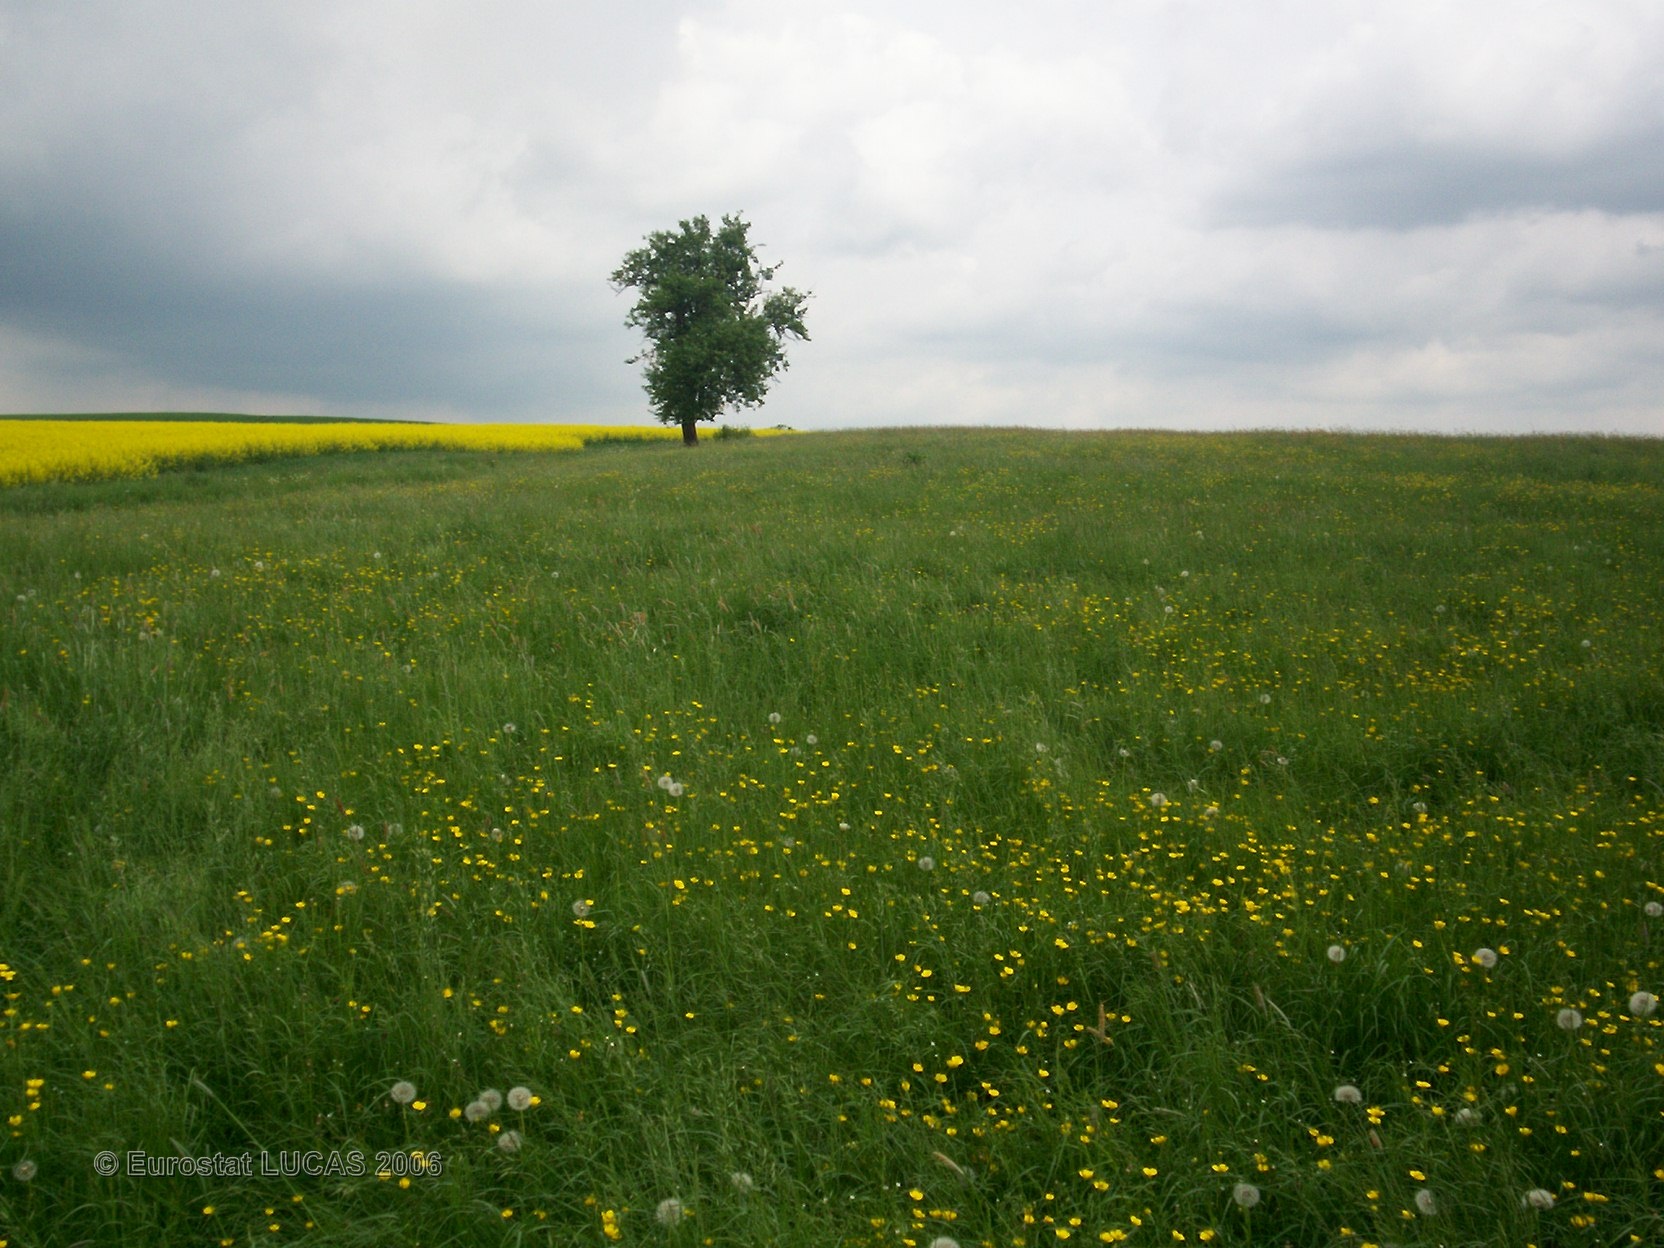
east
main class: Grassland
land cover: Grassland without tree/shrub cover
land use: Agriculture (excluding fallow land and kitchen gardens)
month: May
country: FR
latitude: 49.4083
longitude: 6.4302
